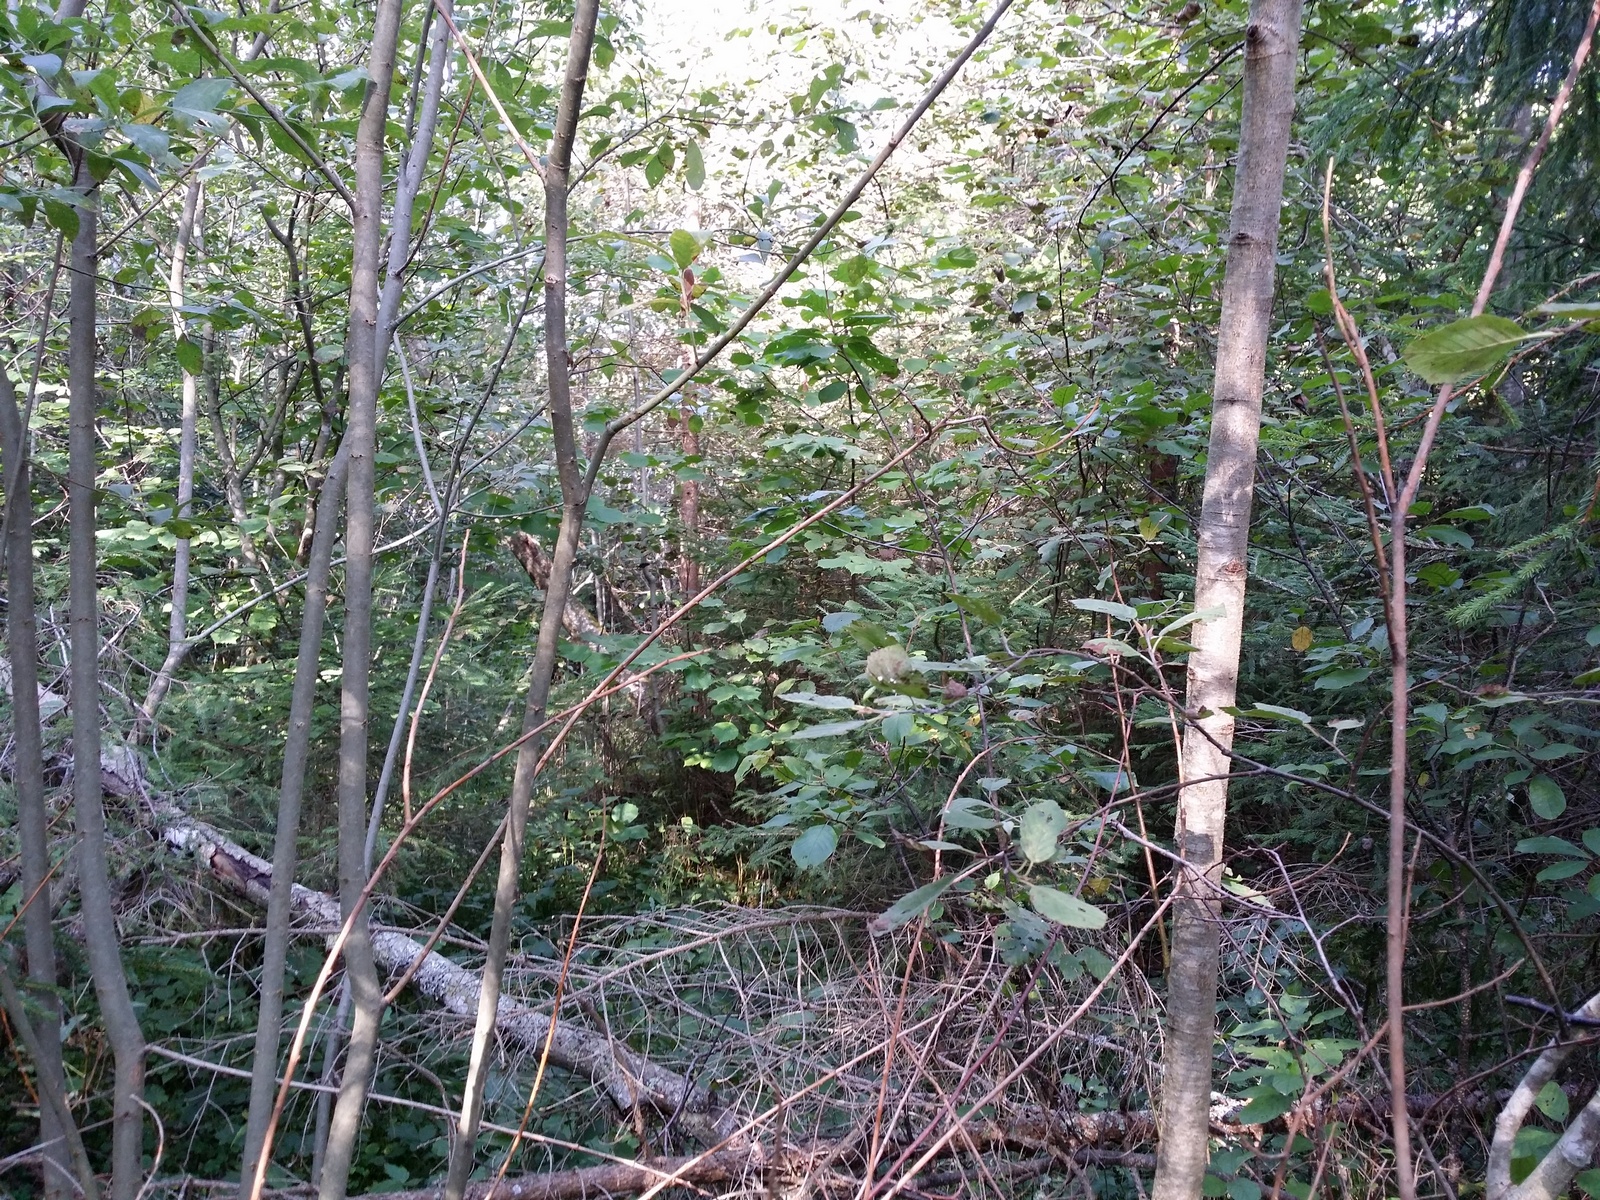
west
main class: Woodland
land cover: Spruce dominated mixed woodland
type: hemiboreal forest and nemoral coniferous forest and mixed broadleaved-coniferous forest
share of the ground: > 75 %
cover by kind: coniferous forest trees 50 %, broadleaved forest trees 35 %, shrubs 10 %, lichens and mosses 5 %
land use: Forestry
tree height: > 5 m
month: August
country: LV
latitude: 57.4369
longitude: 26.8623
